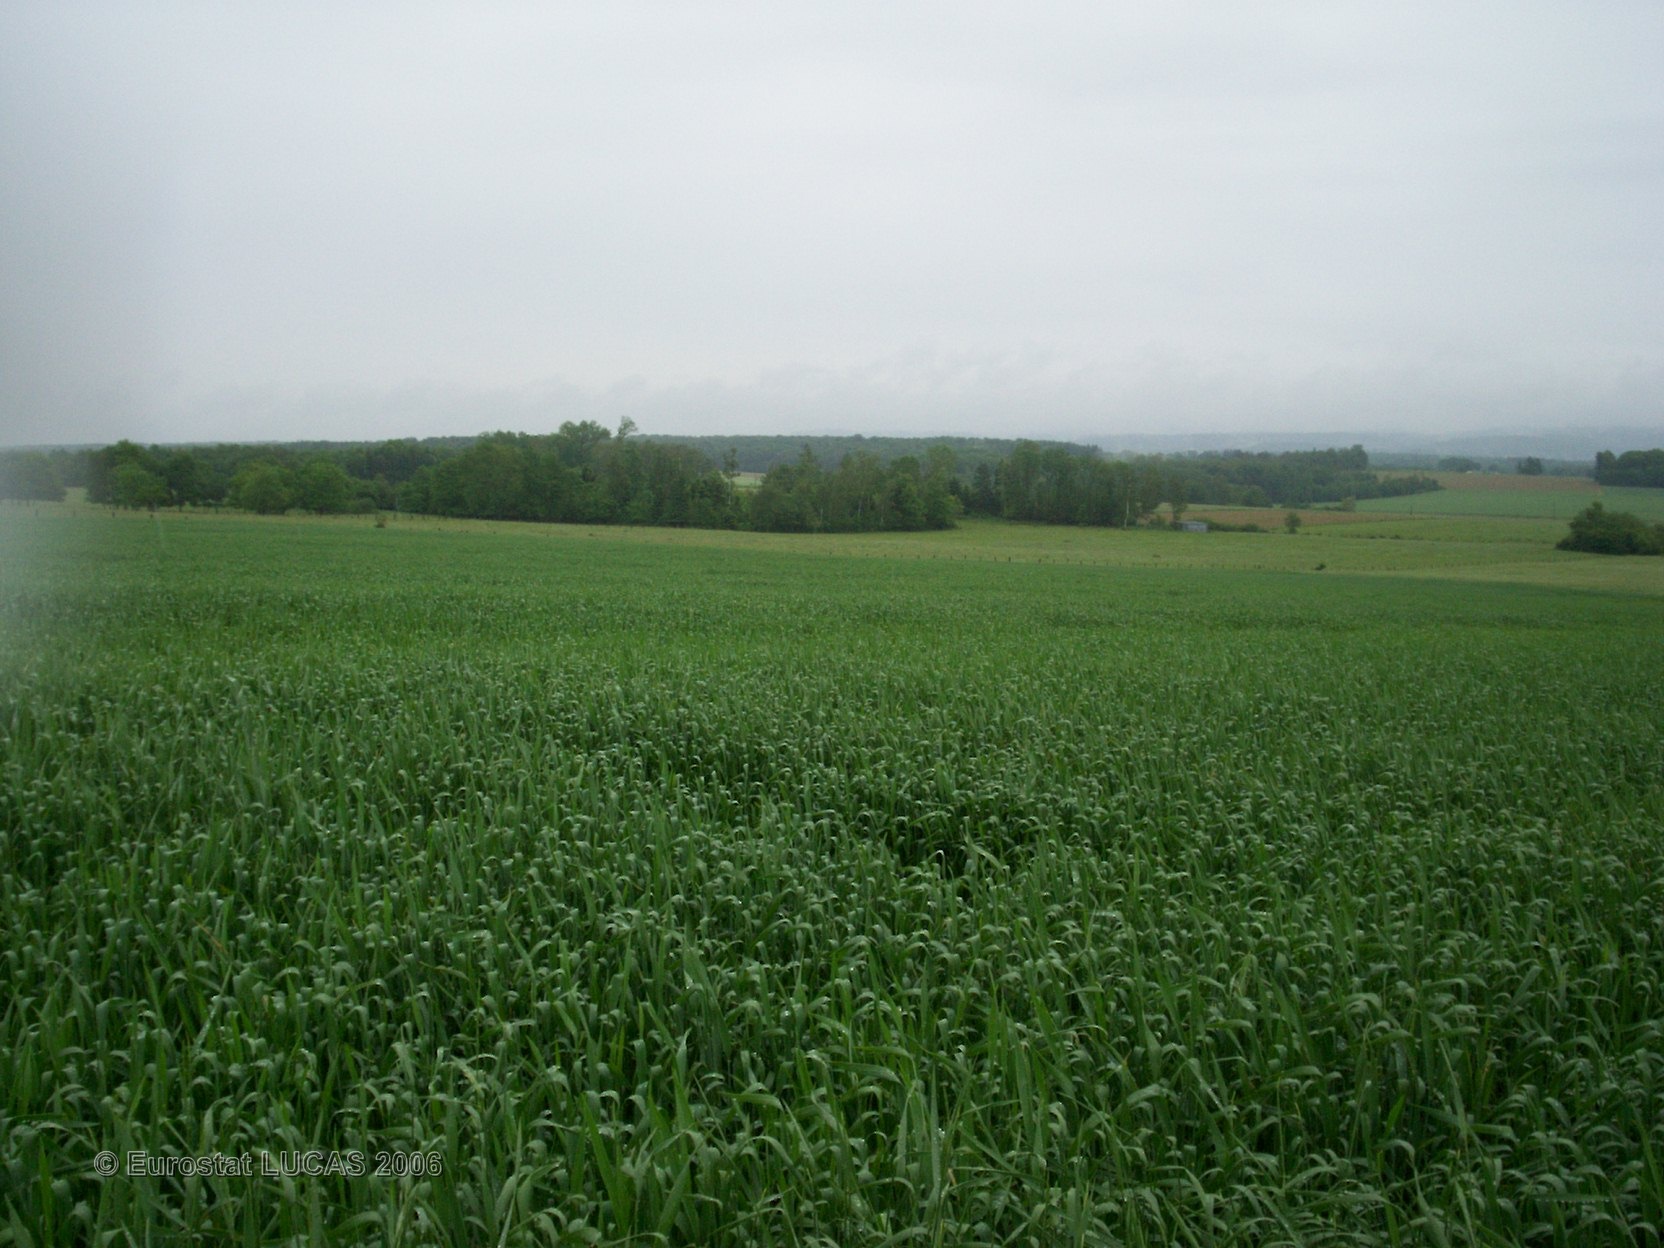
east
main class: Cropland
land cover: Barley
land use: Agriculture (excluding fallow land and kitchen gardens)
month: May
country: FR
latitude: 48.5198
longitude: 6.8190
